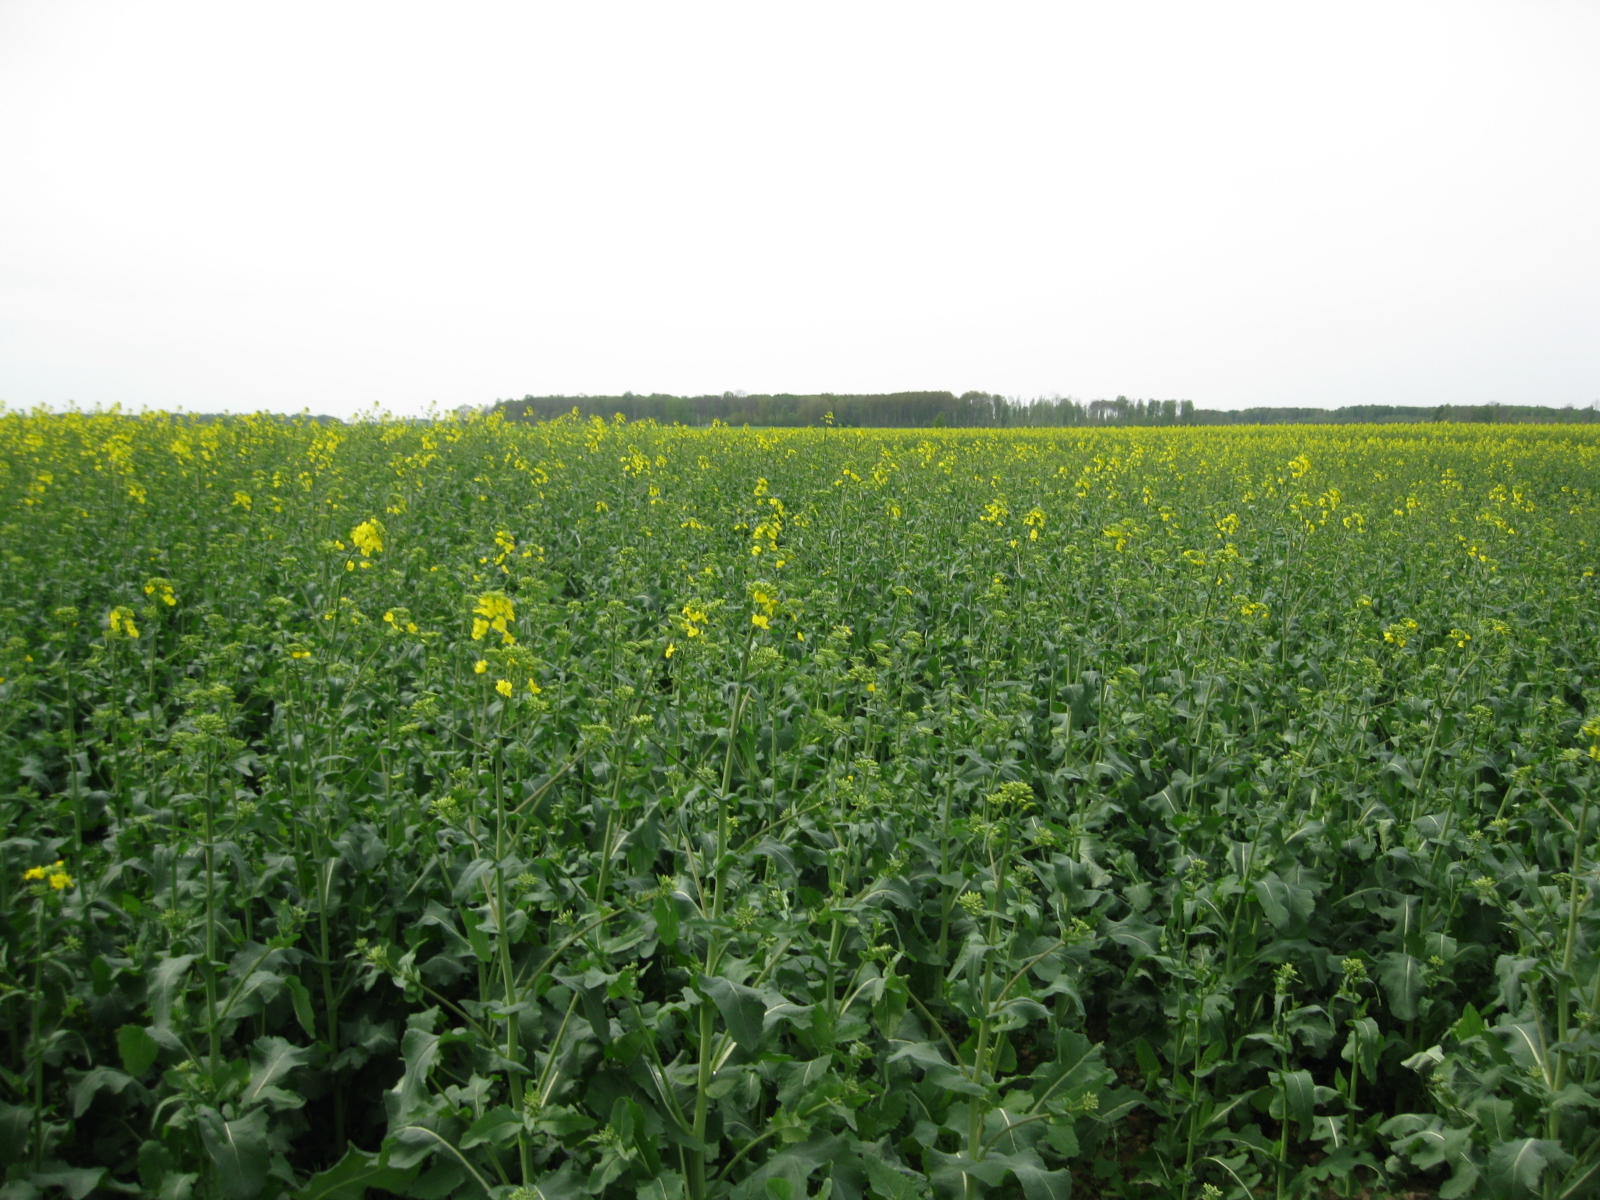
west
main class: Cropland
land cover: Rape and turnip rape
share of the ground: > 75 %
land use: Agriculture (excluding fallow land and kitchen gardens)
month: May
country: LT
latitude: 56.2647
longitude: 24.2510
